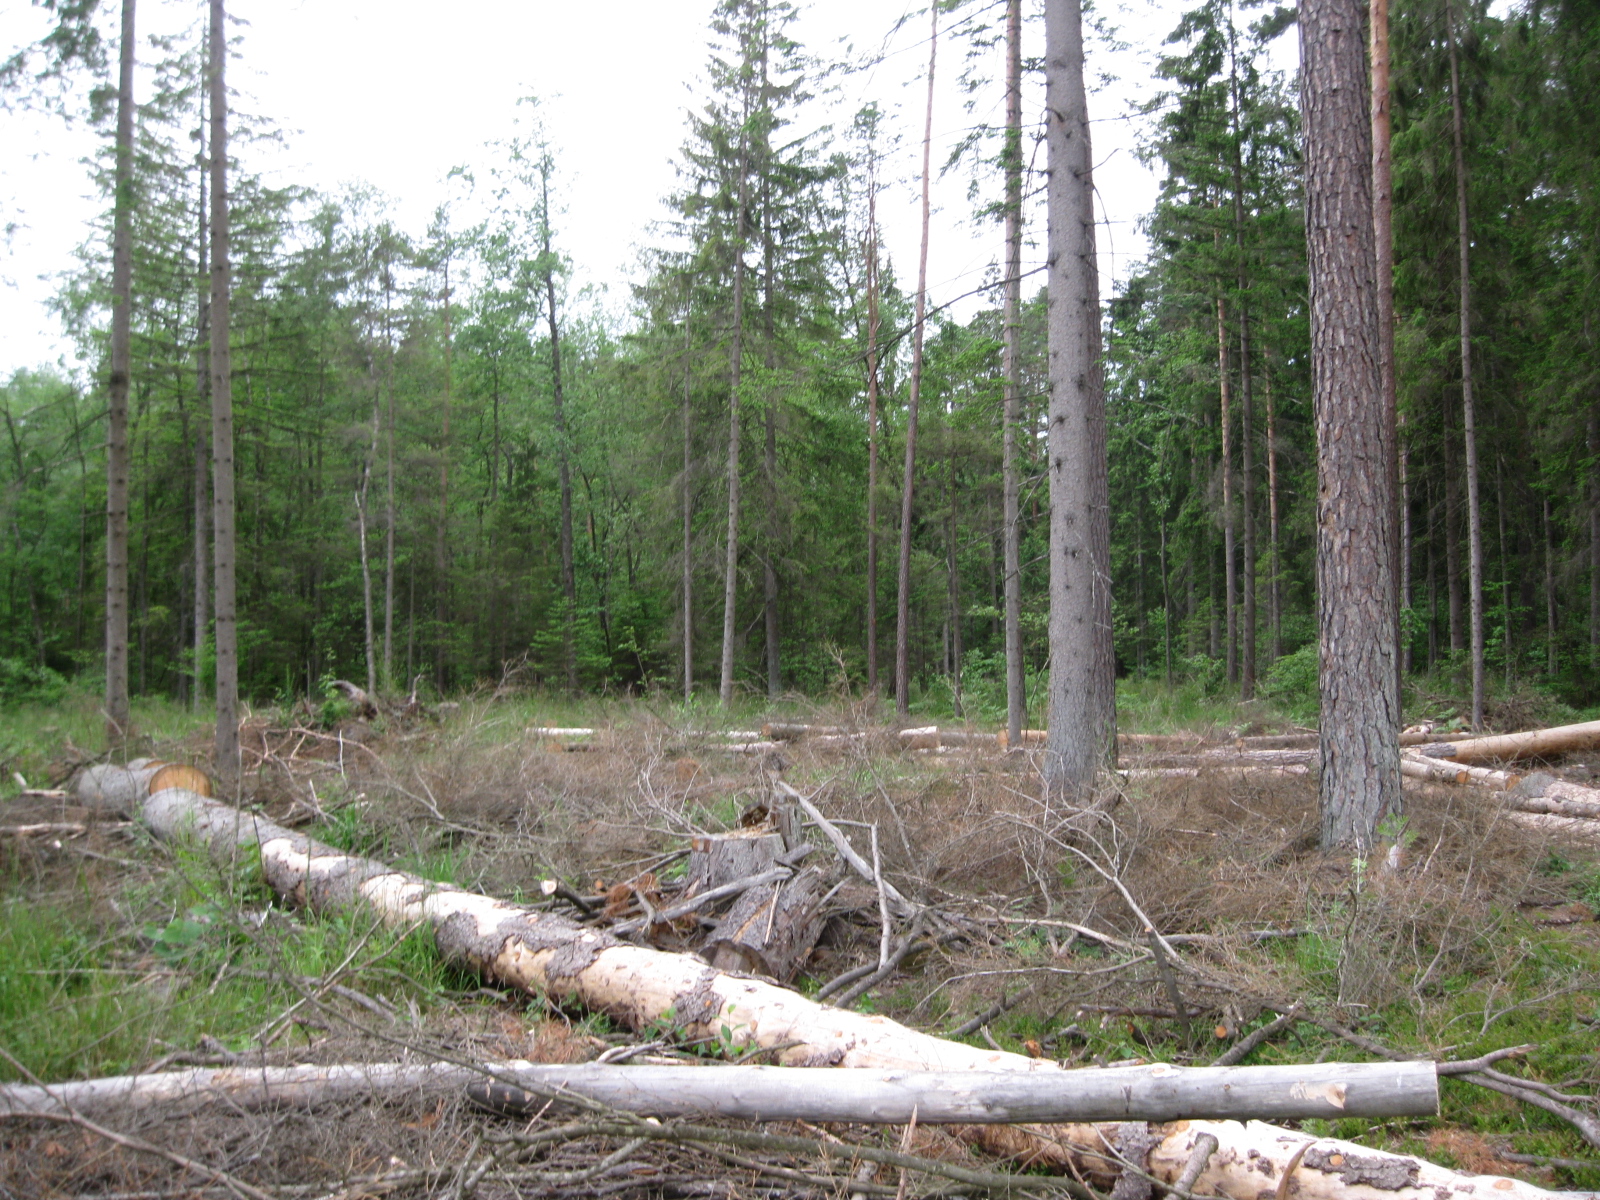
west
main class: Woodland
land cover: Other coniferous woodland
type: hemiboreal forest and nemoral coniferous forest and mixed broadleaved-coniferous forest
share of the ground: 50 - 75 %
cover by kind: coniferous forest trees 50 %, herbaceous plants 20 %, broadleaved forest trees 10 %, shrubs 10 %, unconsolidated bare surface 10 %
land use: Forestry
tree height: > 5 m
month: June
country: LT
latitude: 55.5409
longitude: 24.1810
